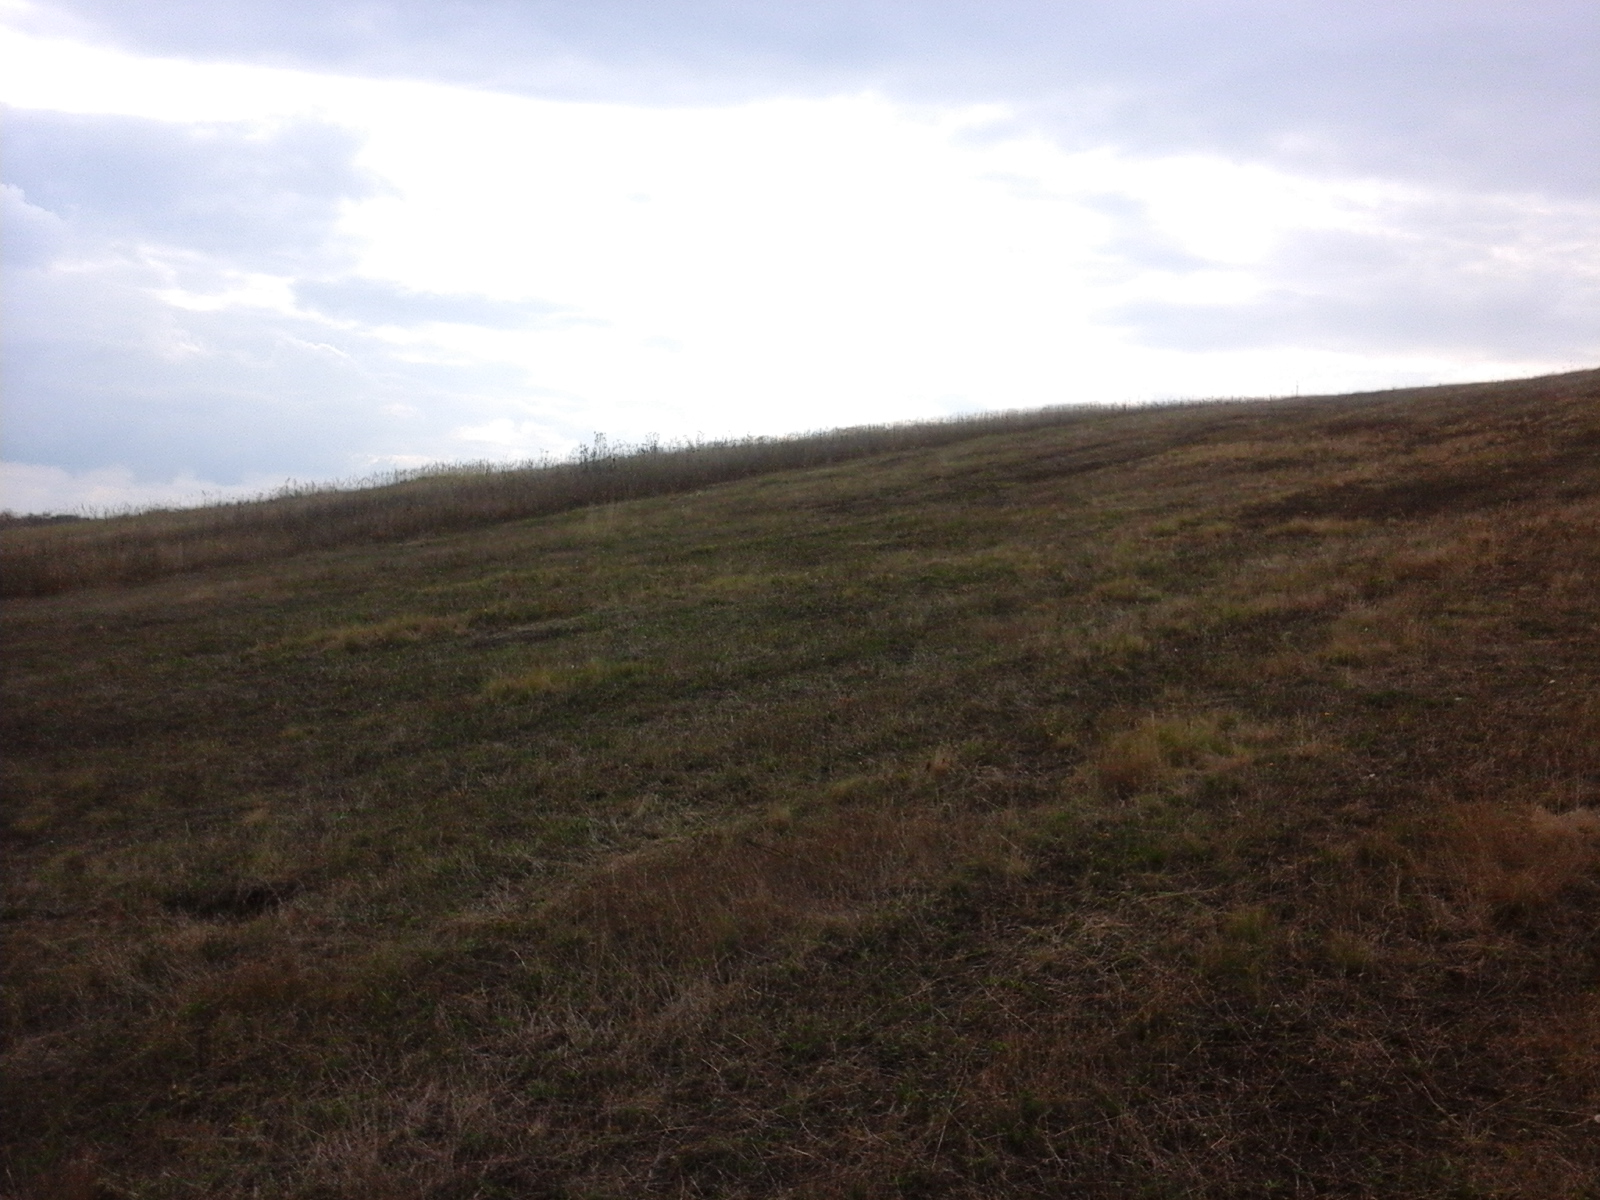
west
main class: Grassland
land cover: Grassland without tree/shrub cover
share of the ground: > 75 %
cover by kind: herbaceous plants 100 %
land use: Agriculture (excluding fallow land and kitchen gardens)
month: August
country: RO
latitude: 45.5511
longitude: 21.6264
